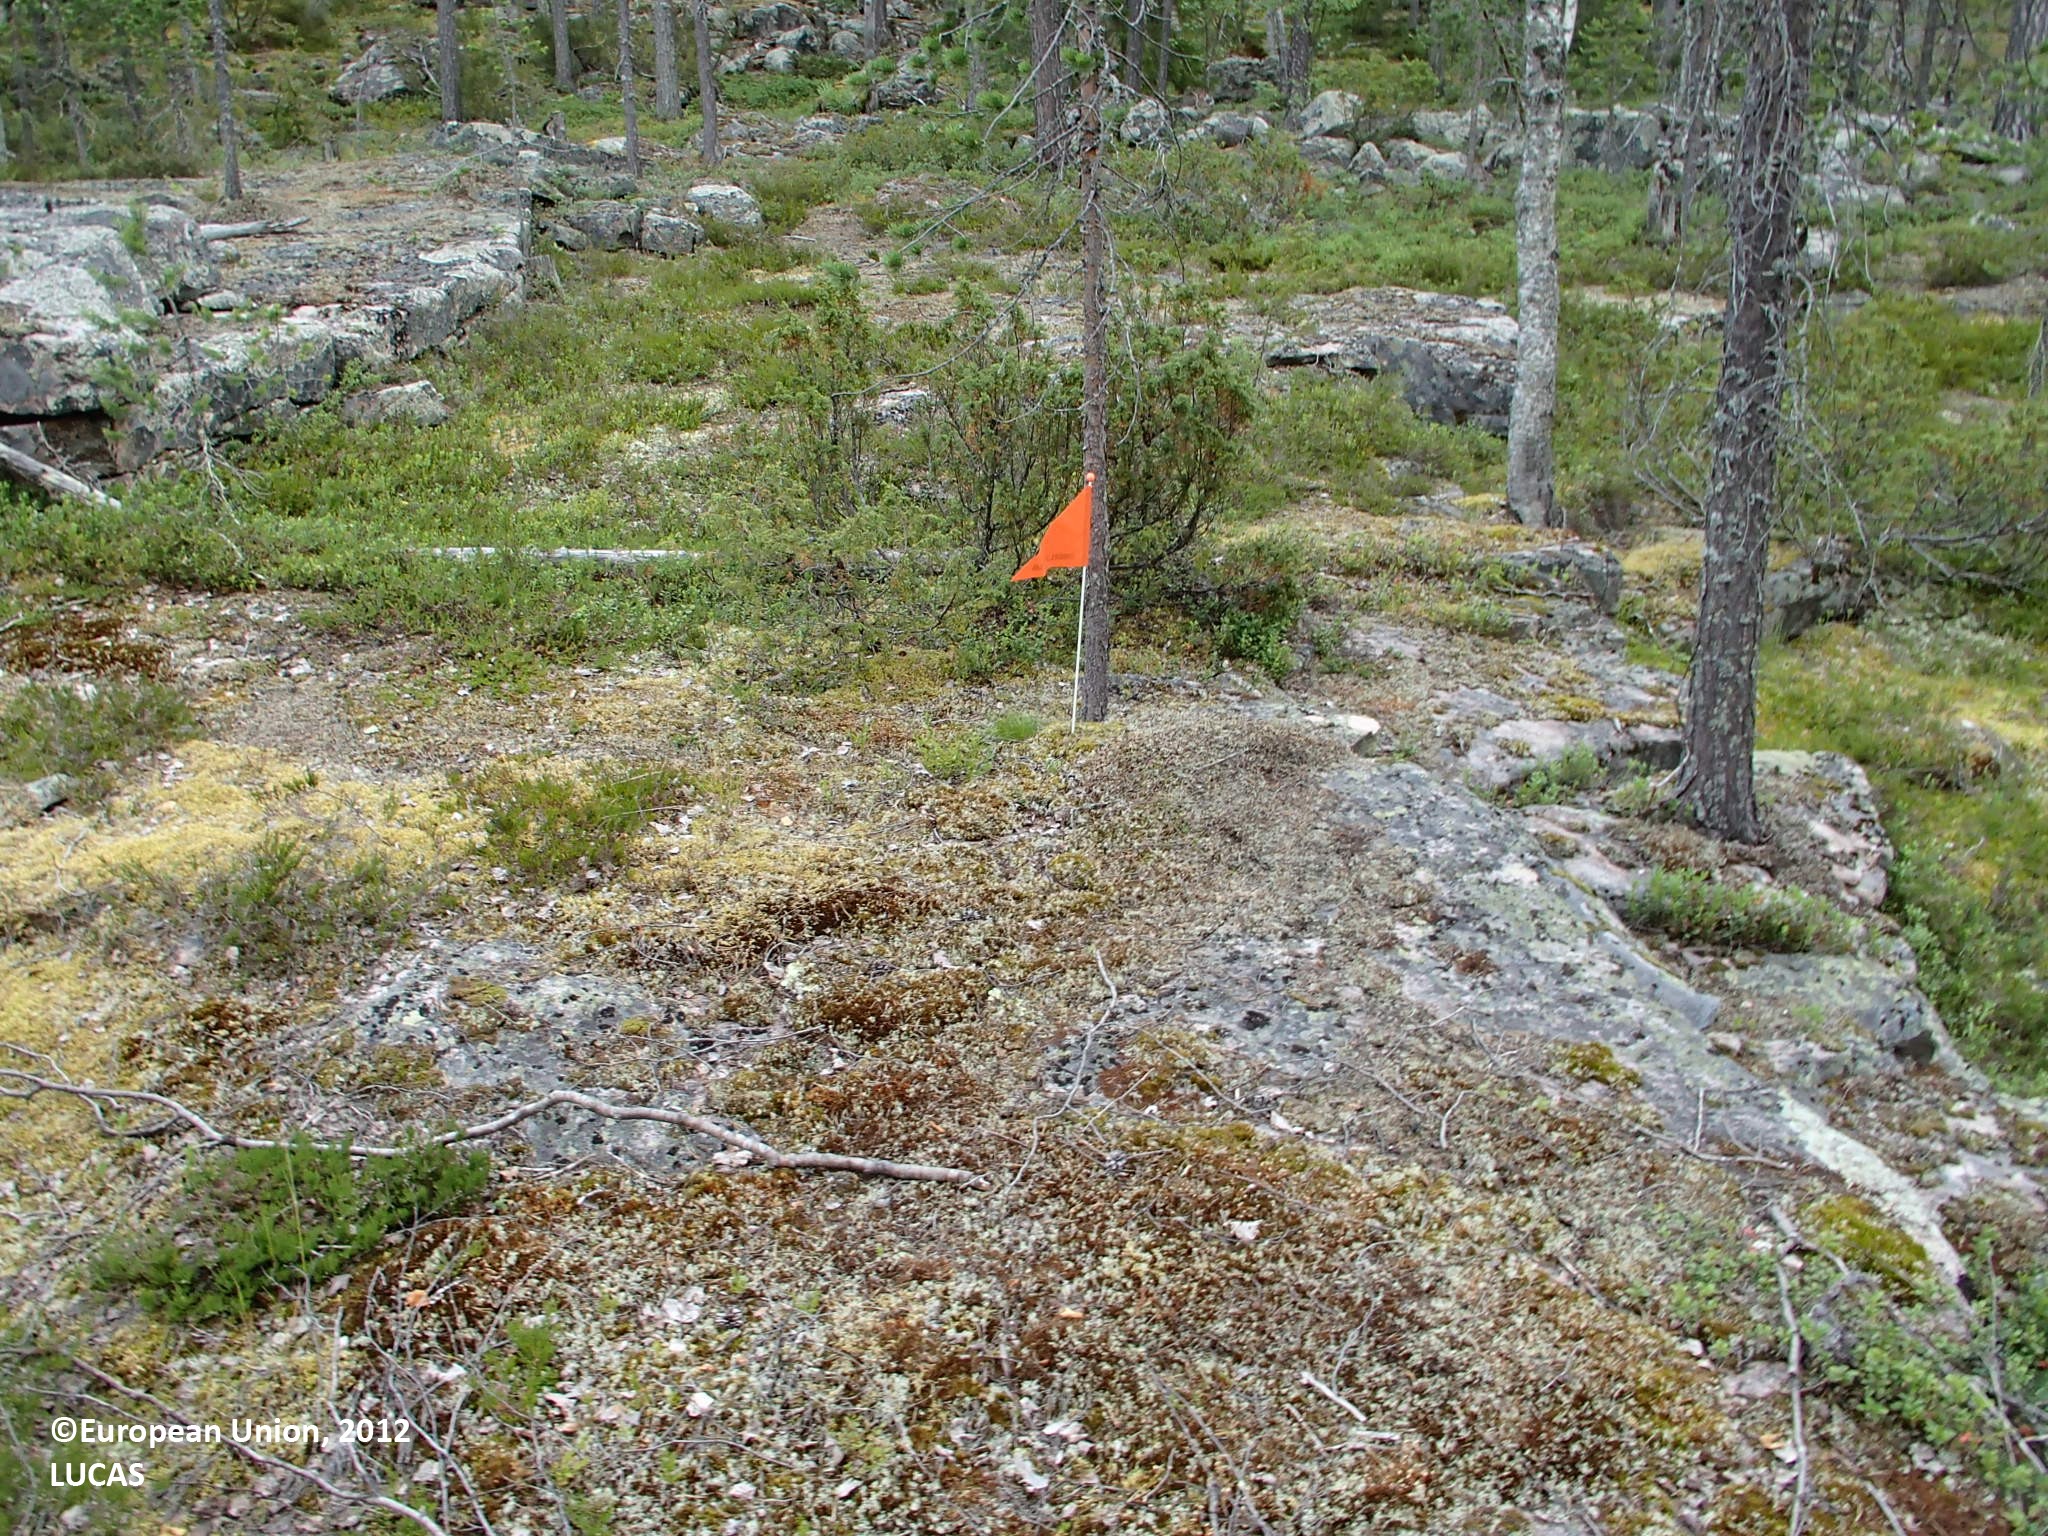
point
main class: Woodland
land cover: Other mixed woodland
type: boreal forest
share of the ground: 25 - 50 %
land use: Forestry
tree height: > 5 m
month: July
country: FI
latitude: 66.6217
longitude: 25.5792
